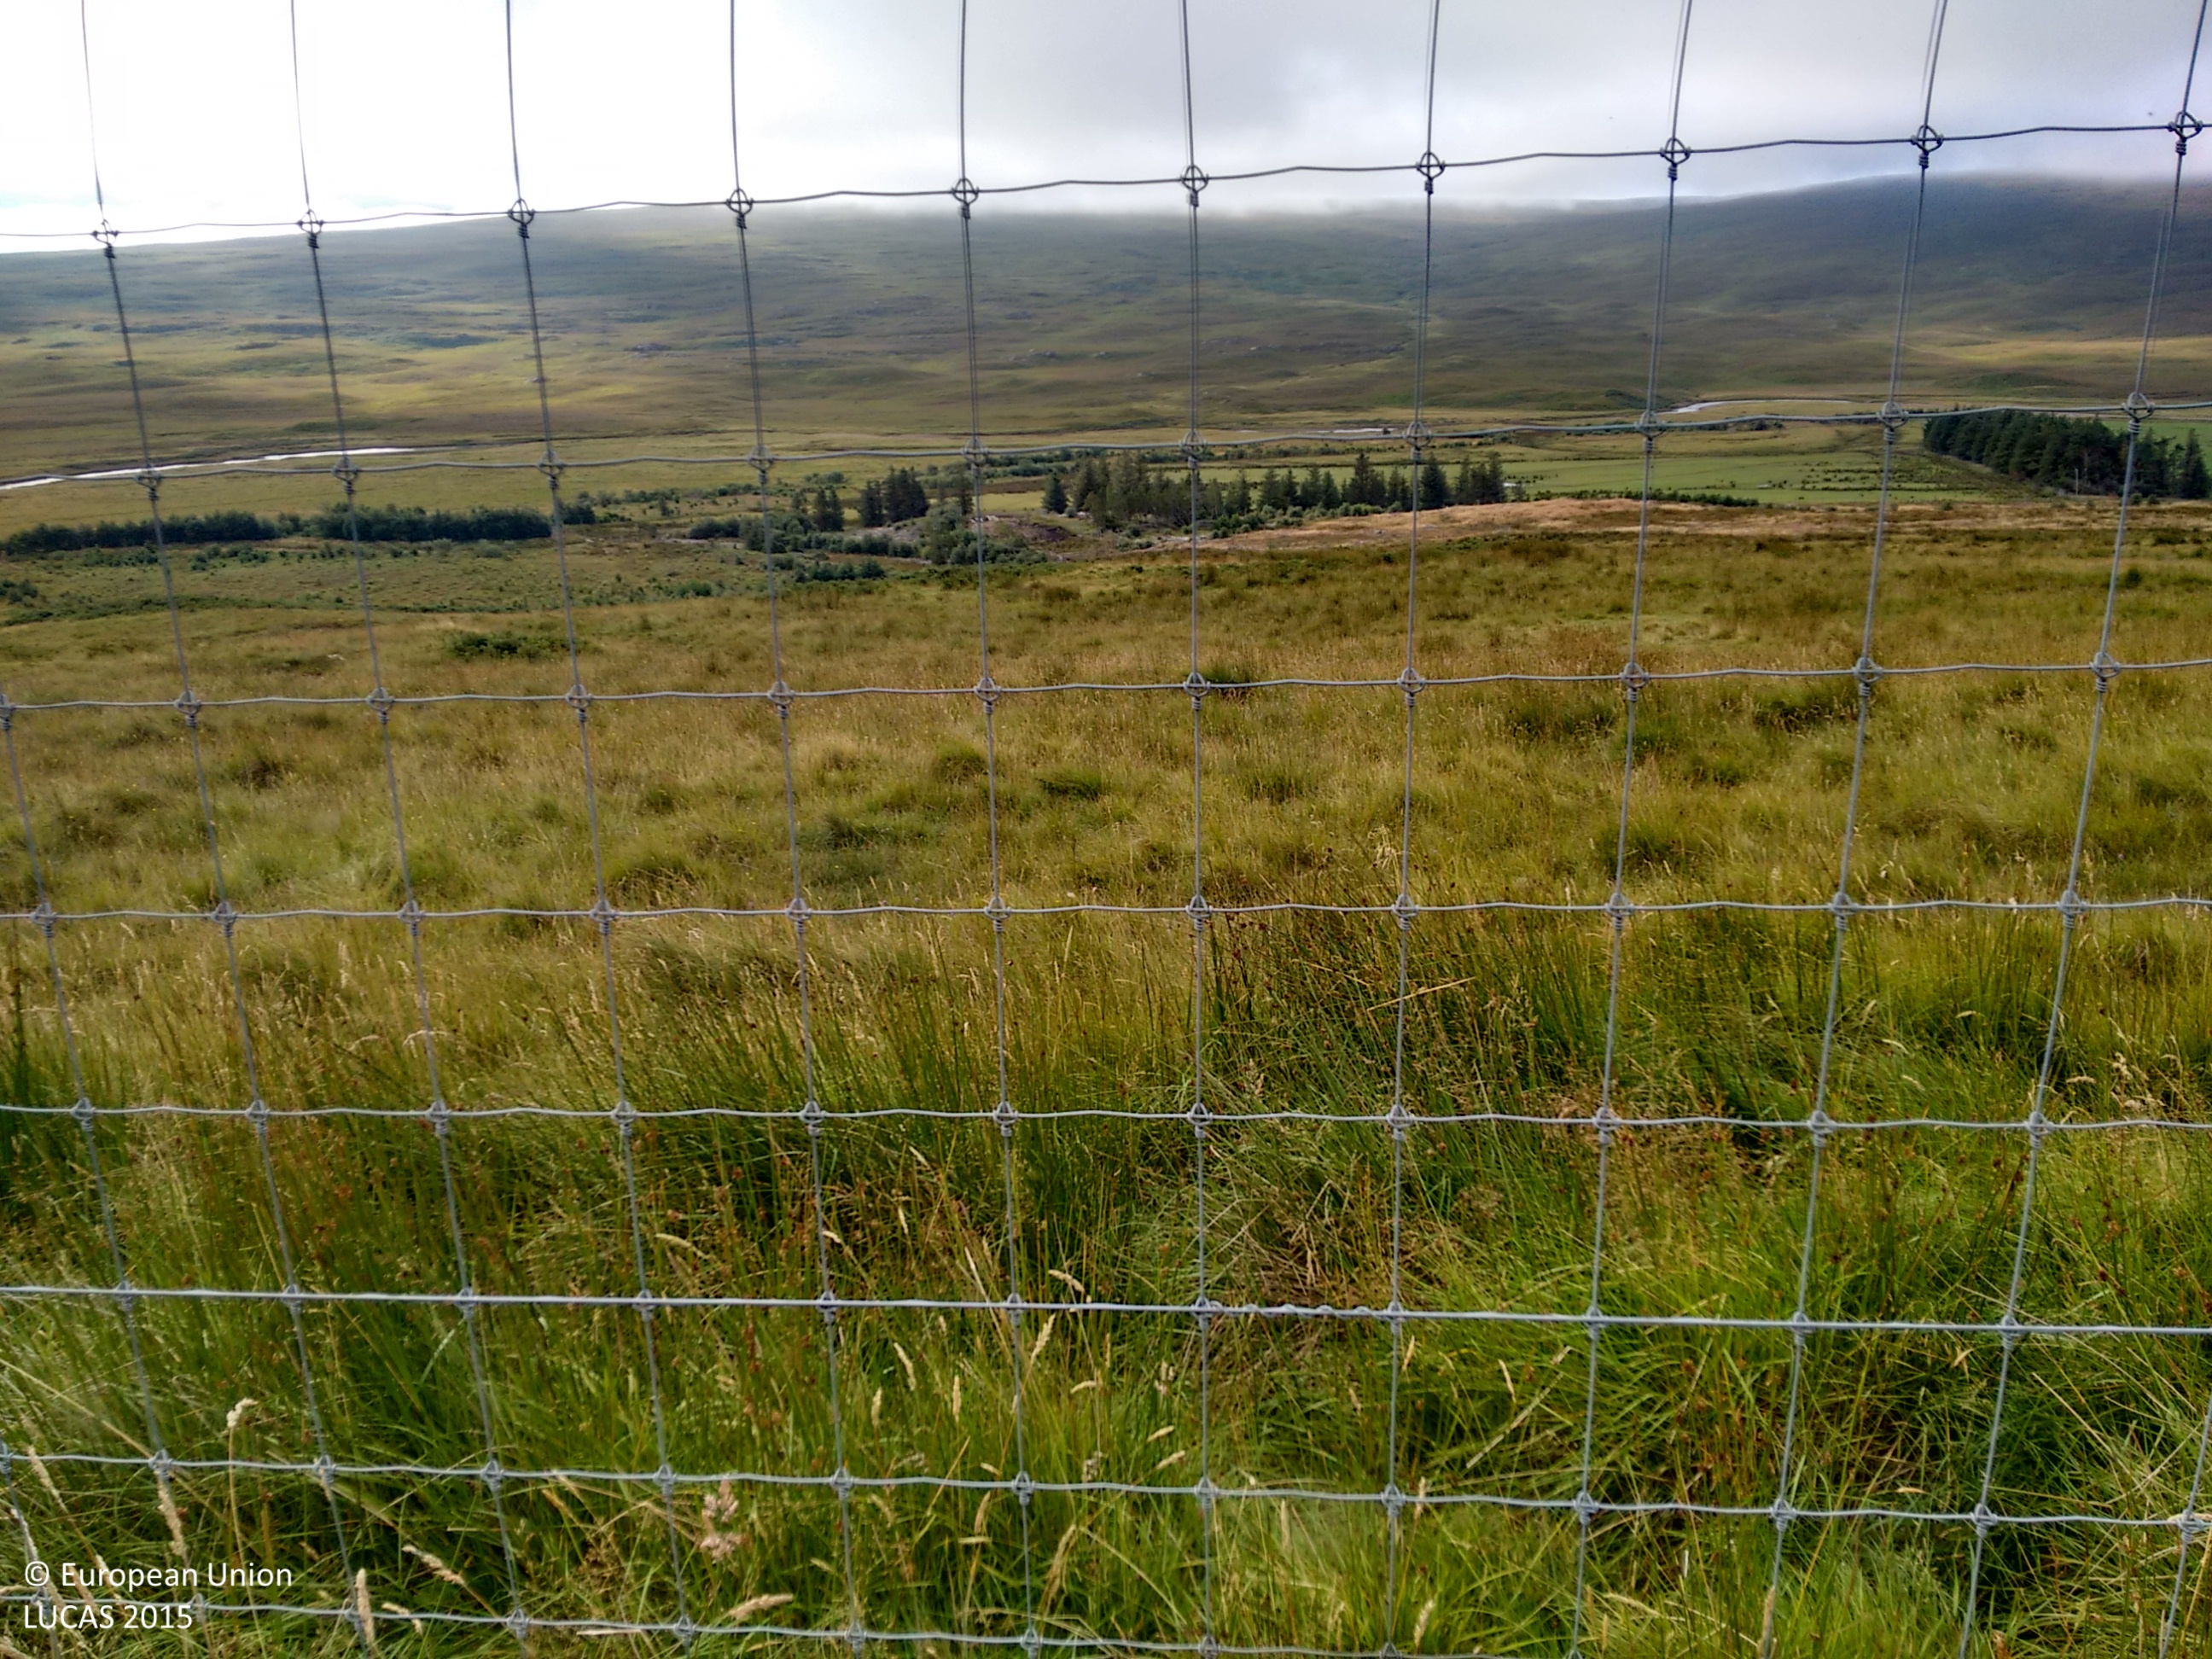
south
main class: Grassland
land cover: Grassland without tree/shrub cover
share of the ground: > 75 %
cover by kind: herbaceous plants 100 %
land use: Agriculture (excluding fallow land and kitchen gardens)
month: September
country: GB
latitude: 58.2886
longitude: -4.4993
